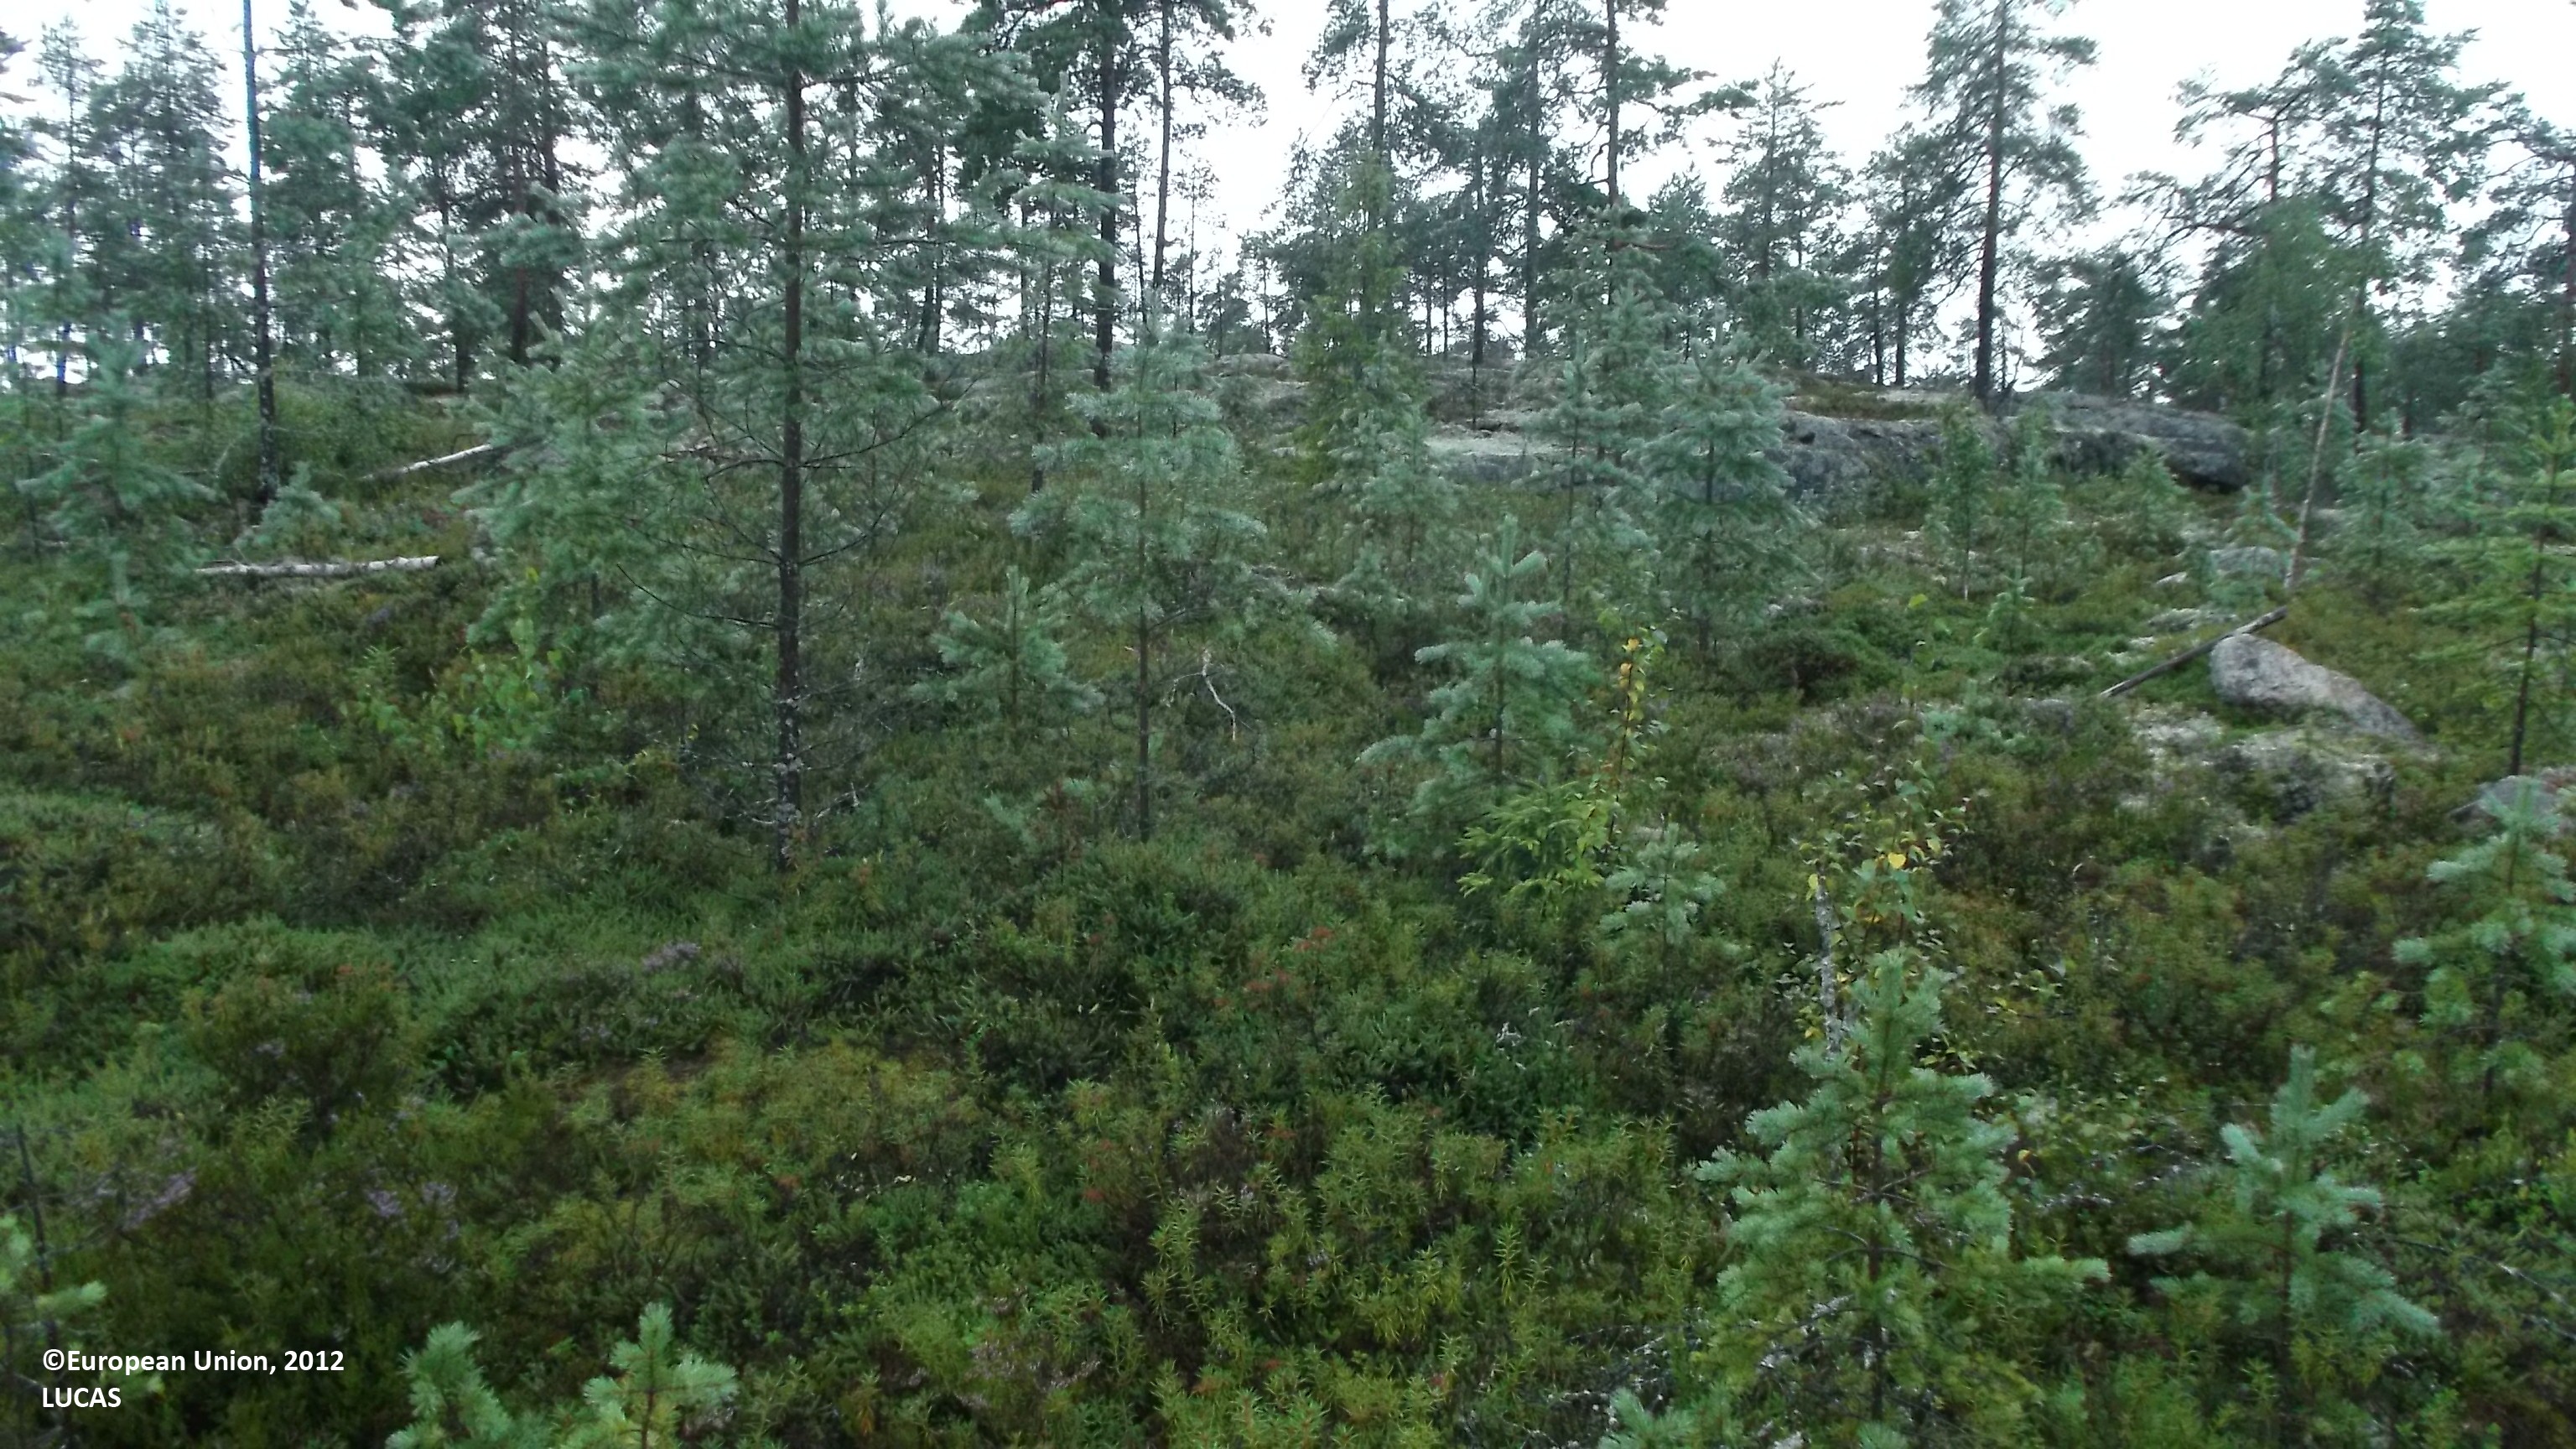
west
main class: Woodland
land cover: Pine dominated coniferous woodland
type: boreal forest
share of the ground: 10 - 25 %
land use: Forestry
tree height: < 5 m
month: August
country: FI
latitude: 63.2343
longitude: 23.8636
